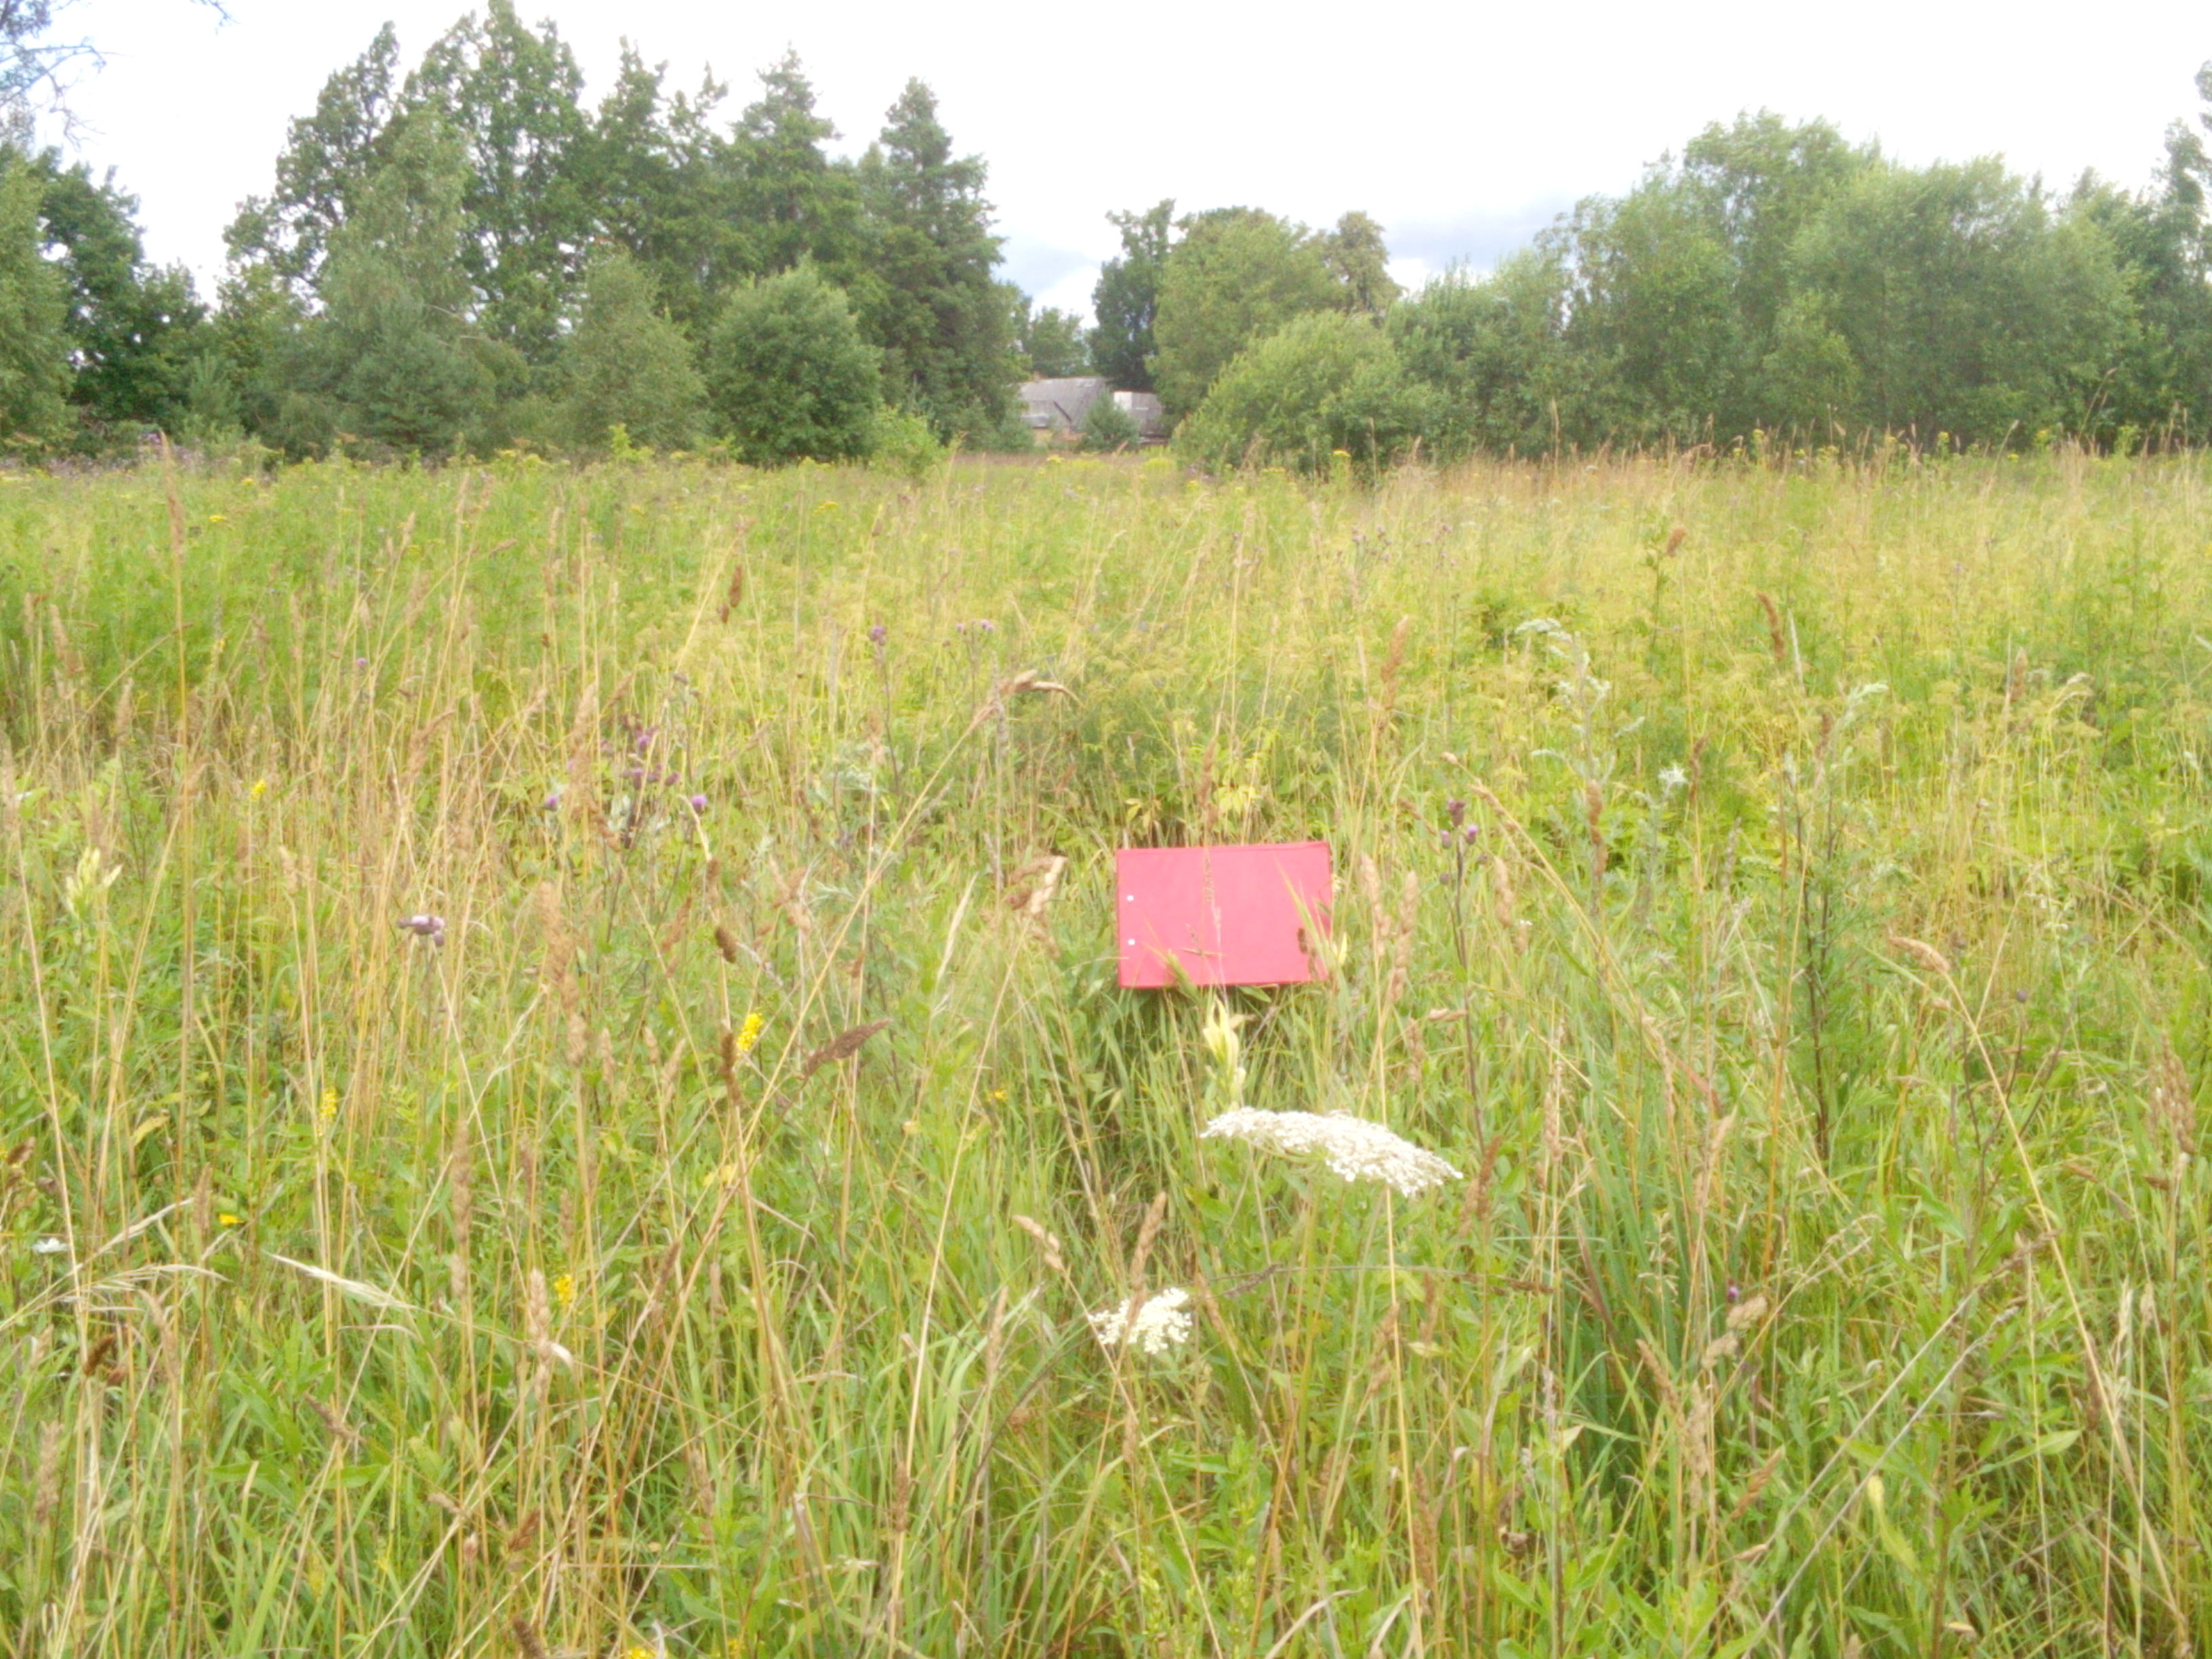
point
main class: Grassland
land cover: Grassland with sparse tree/shrub cover
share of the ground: > 75 %
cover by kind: herbaceous plants 95 %, broadleaved forest trees 5 %
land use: Semi-natural and natural areas not in use
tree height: < 5 m
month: July
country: LV
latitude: 56.9834
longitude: 22.0440
